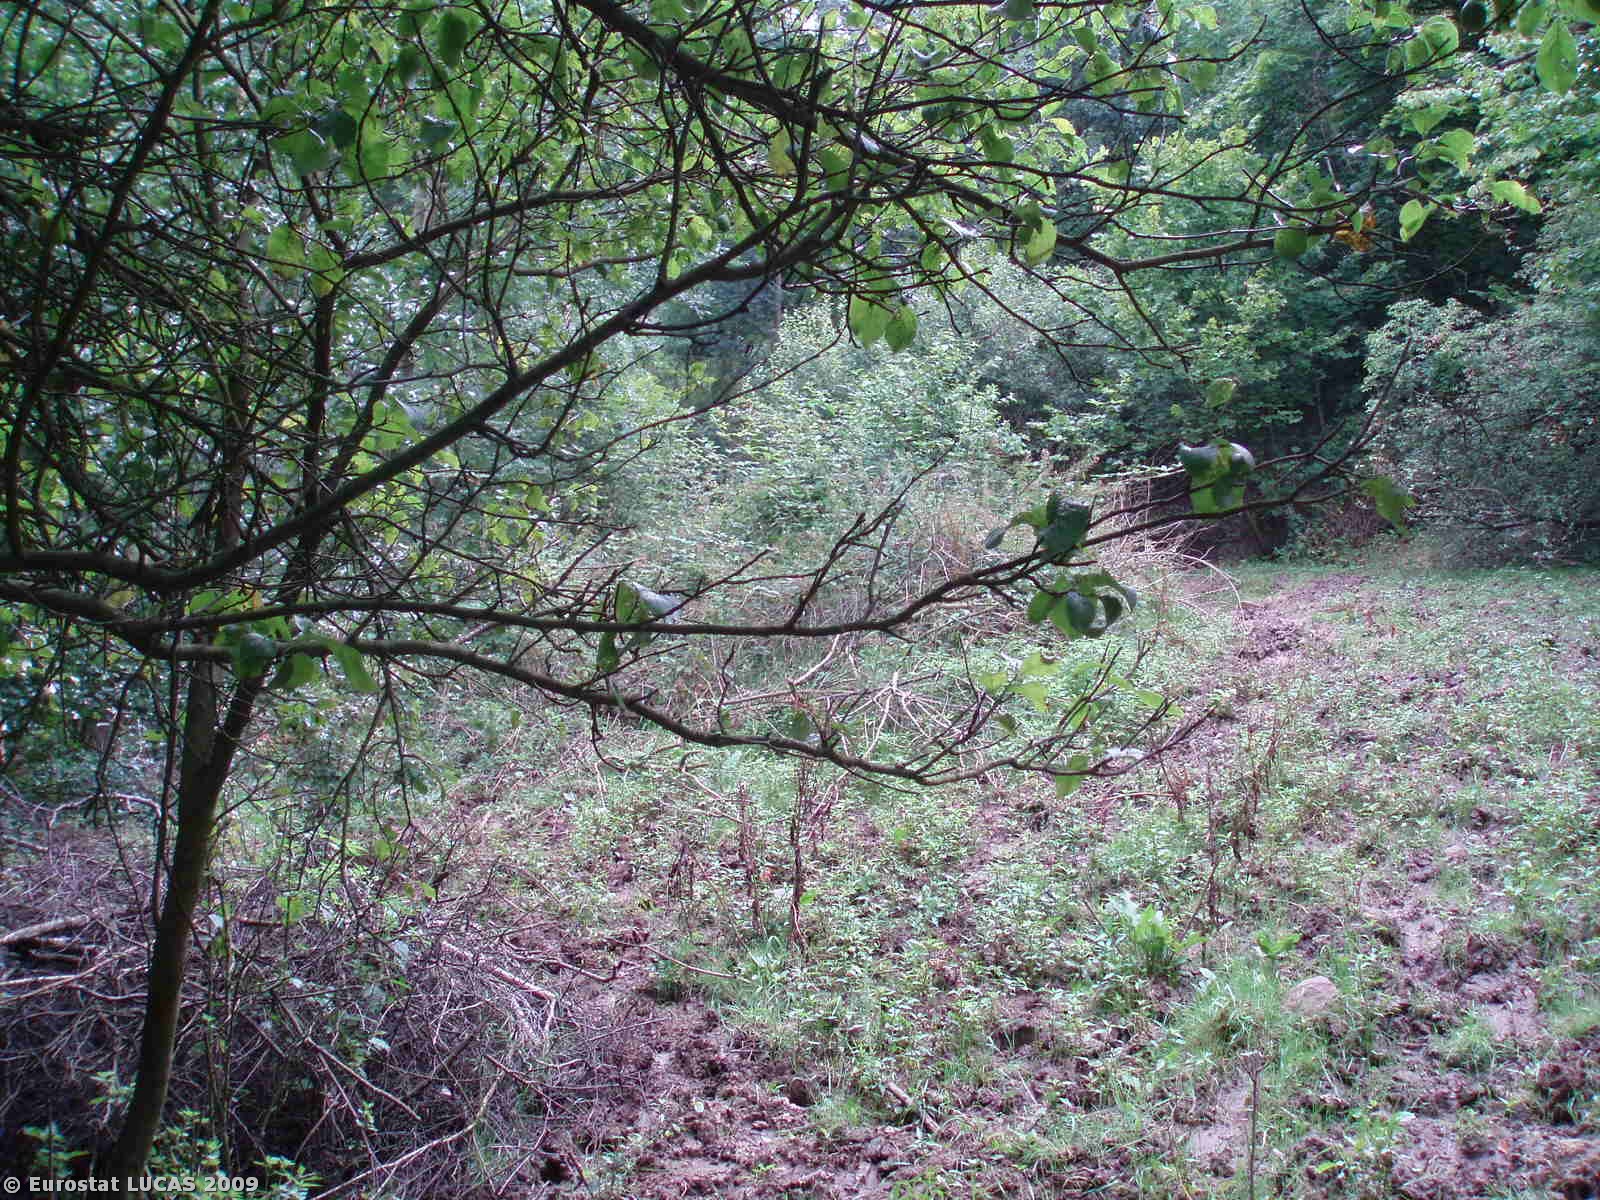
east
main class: Woodland
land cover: Broadleaved woodland
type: mesophytic deciduous forest
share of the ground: > 75 %
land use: Forestry
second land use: Nature reserves
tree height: > 5 m
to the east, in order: Broadleaved woodland; Grassland with sparse tree/shrub cover; Broadleaved woodland; Fences; Broadleaved woodland
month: July
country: CZ
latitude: 50.7009
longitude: 14.2064
